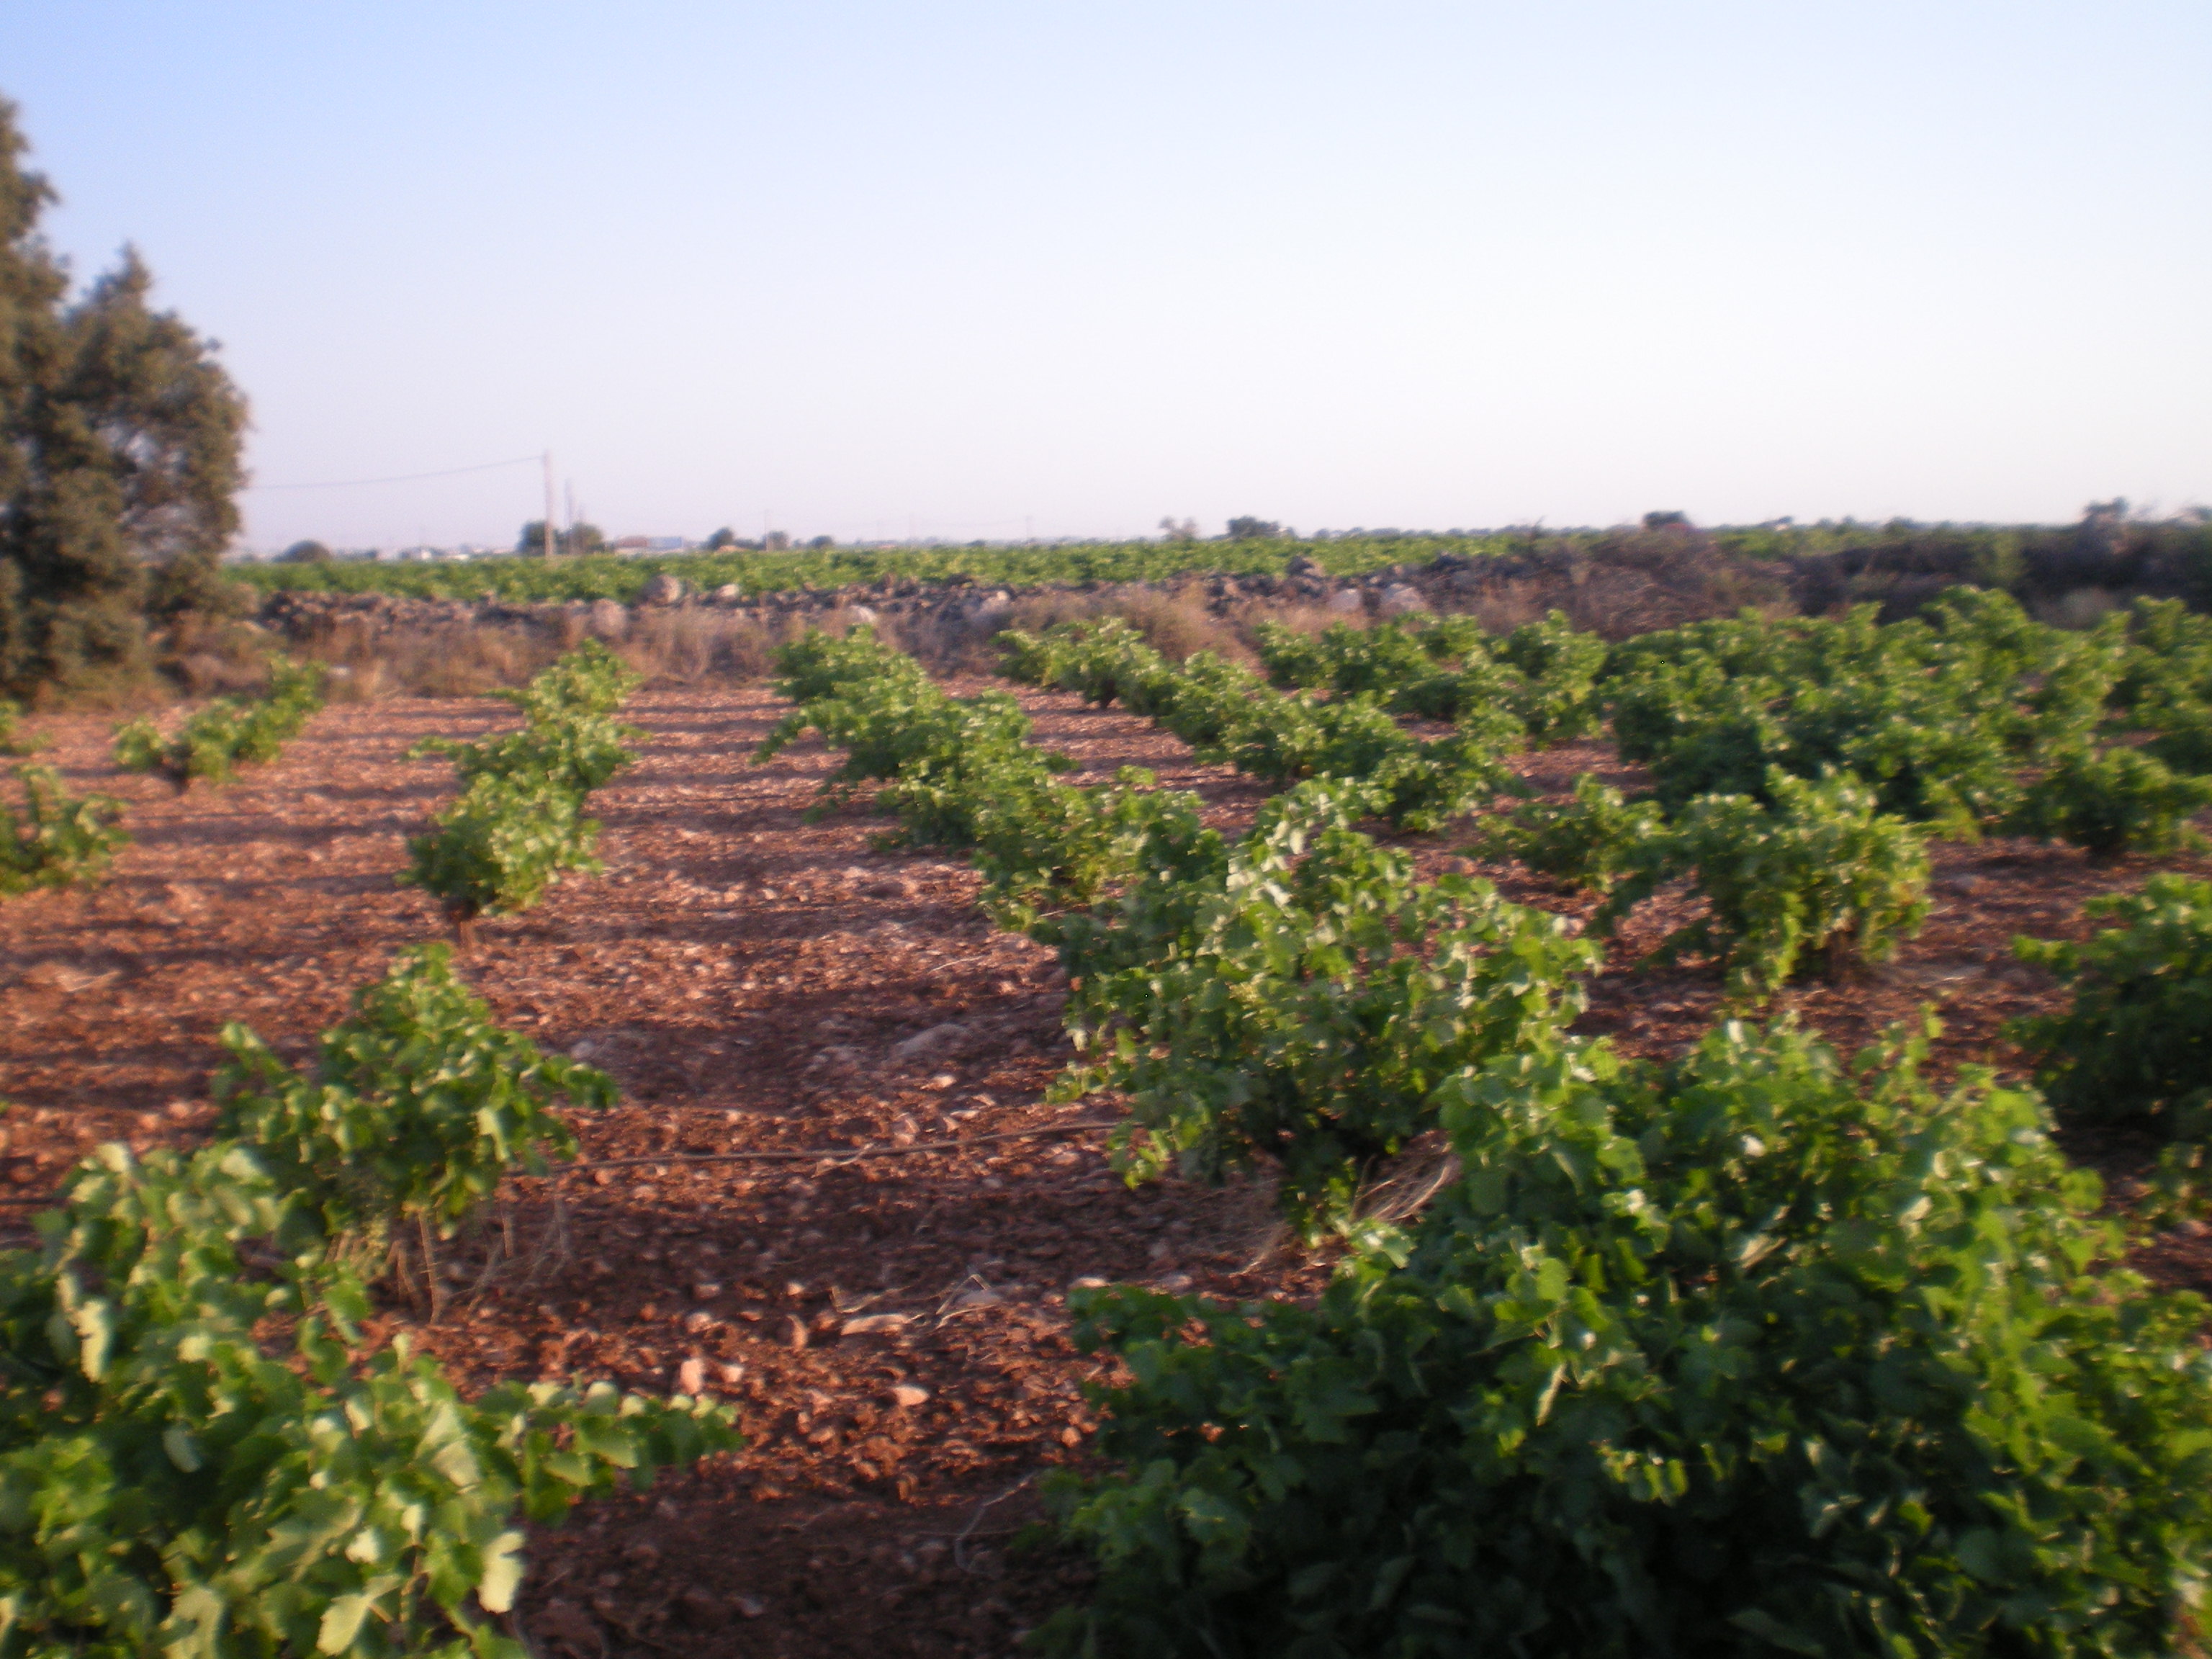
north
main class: Cropland
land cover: Vineyards
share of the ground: 25 - 50 %
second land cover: Other bare soil
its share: > 75 %
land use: Agriculture (excluding fallow land and kitchen gardens)
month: July
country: ES
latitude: 39.4831
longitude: -3.0503
